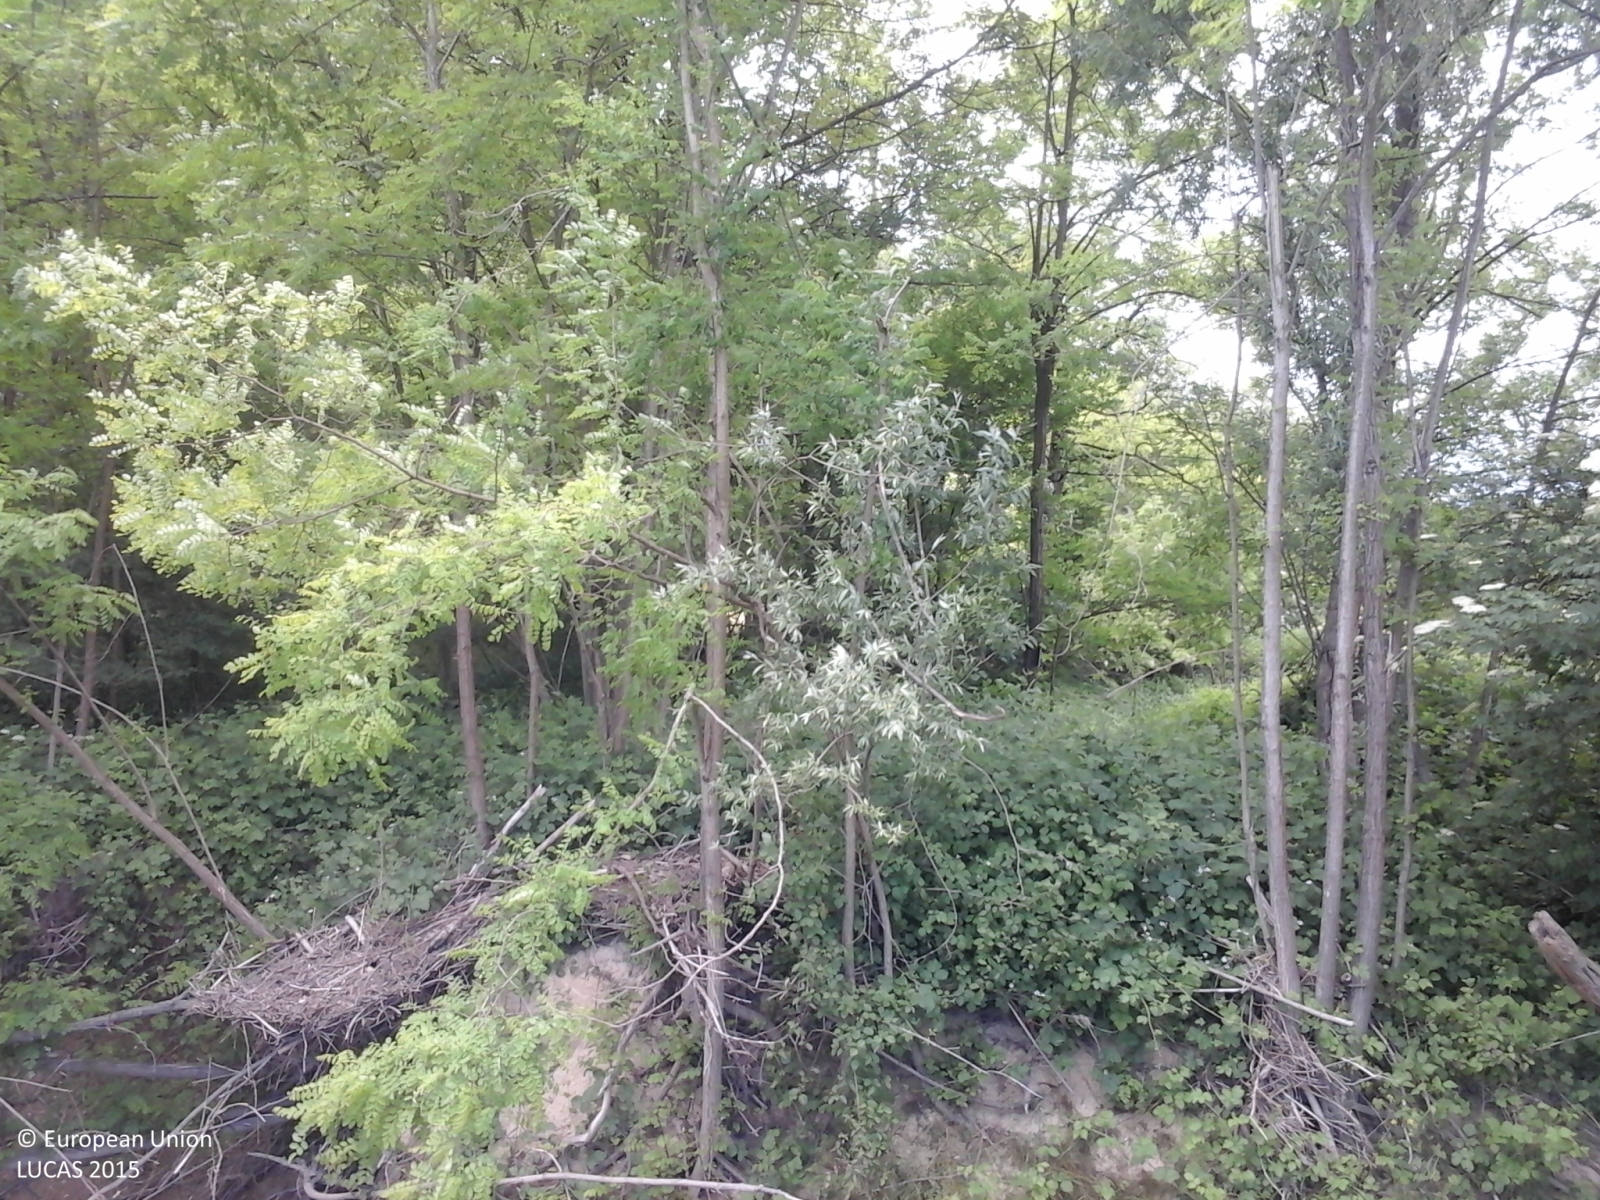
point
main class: Woodland
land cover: Broadleaved woodland
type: mesophytic deciduous forest
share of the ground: > 75 %
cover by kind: broadleaved forest trees 80 %, shrubs 10 %, herbaceous plants 10 %
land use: Forestry
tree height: > 5 m
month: May
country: IT
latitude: 44.8432
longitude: 8.3964
